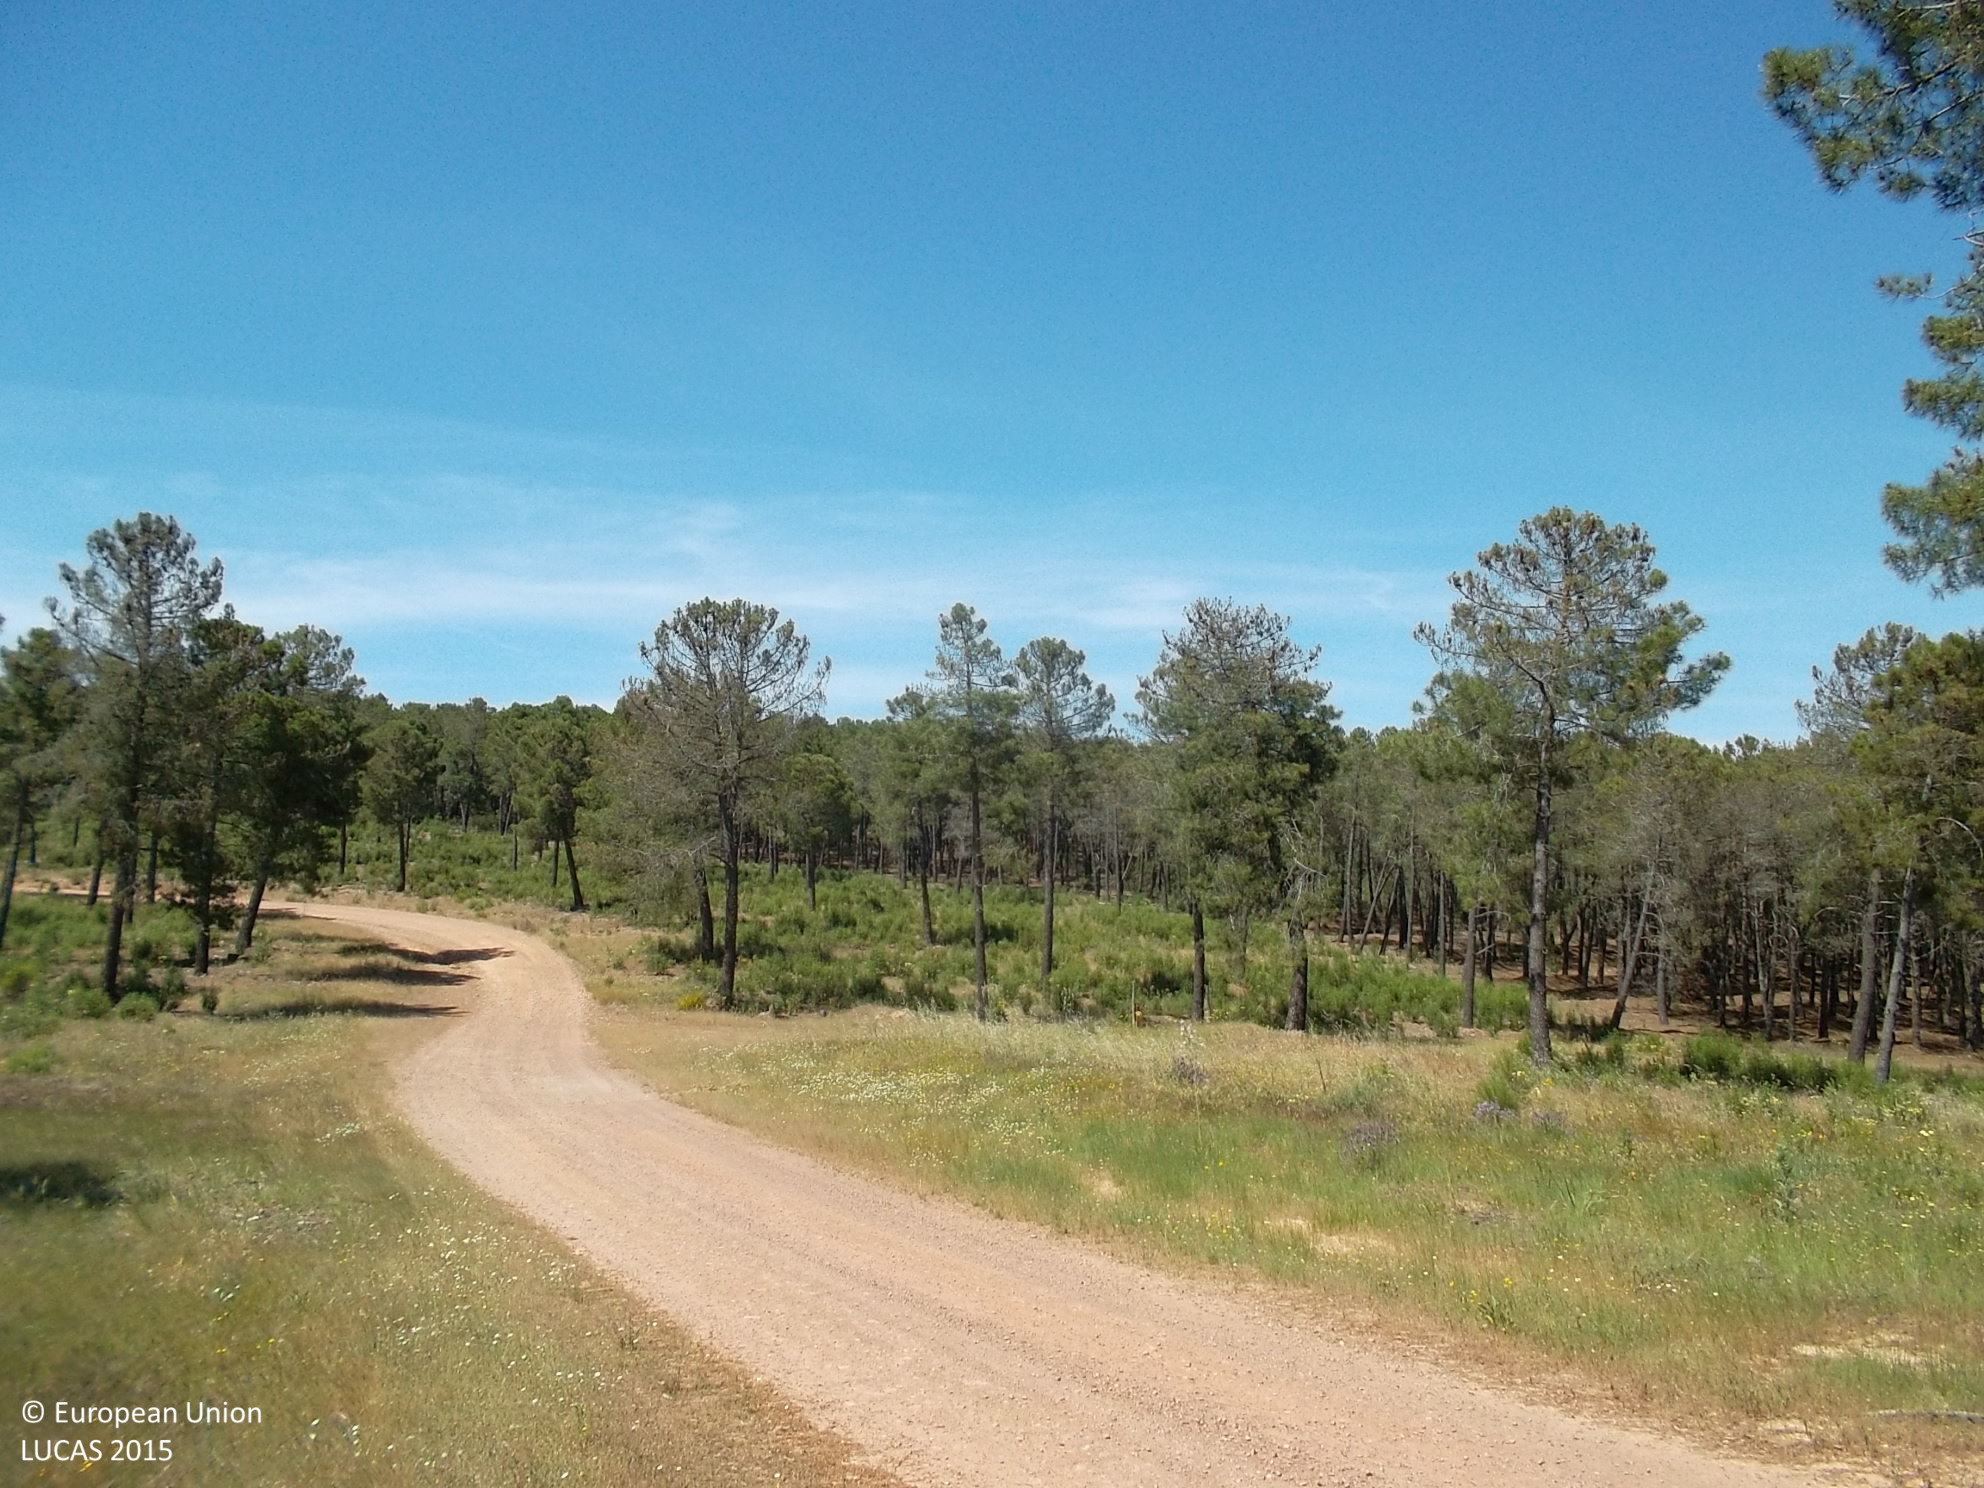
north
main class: Woodland
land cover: Pine dominated coniferous woodland
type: broadleaved evergreen forest
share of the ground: 25 - 50 %
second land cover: Spontaneously vegetated surfaces
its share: > 75 %
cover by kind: coniferous forest trees 40 %, herbaceous plants 30 %, consolidated bare surface 20 %, shrubs 10 %
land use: Forestry
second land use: Agriculture (excluding fallow land and kitchen gardens)
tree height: > 5 m
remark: Clear cut
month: May
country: ES
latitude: 38.8197
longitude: -4.4797
